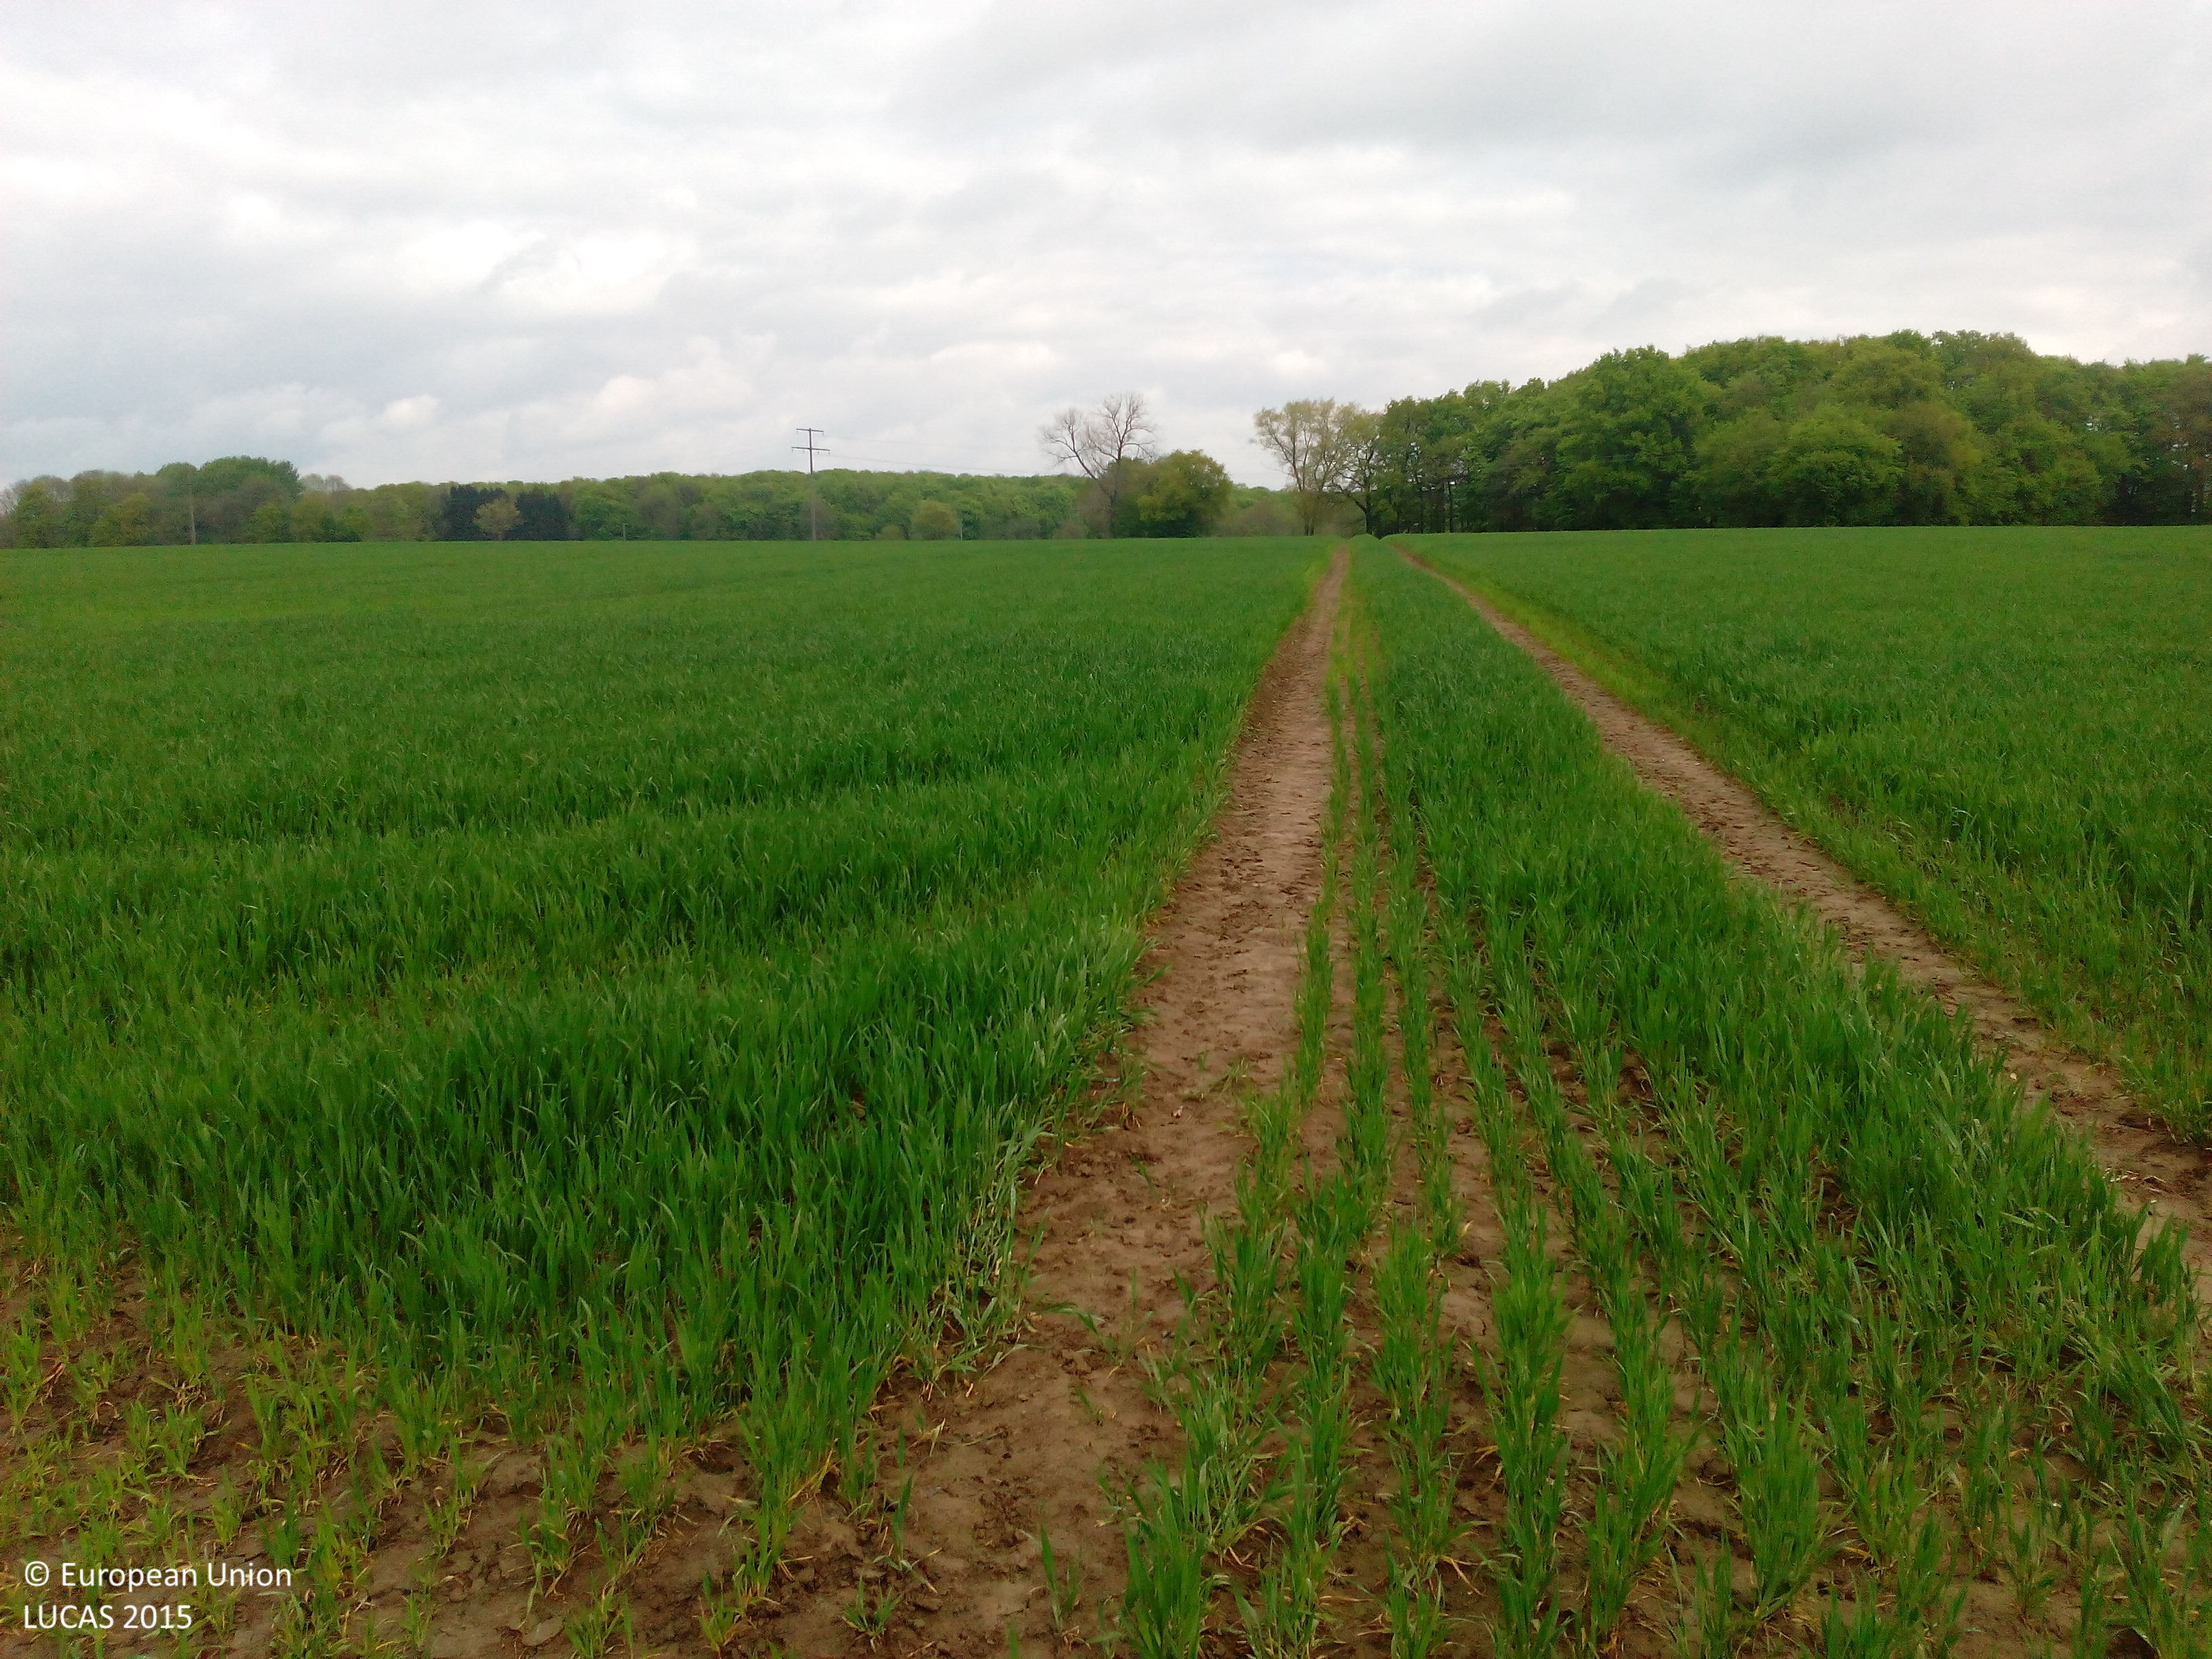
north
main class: Cropland
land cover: Common wheat
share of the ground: > 75 %
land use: Agriculture (excluding fallow land and kitchen gardens)
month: May
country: DE
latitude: 51.9174
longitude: 7.3978
